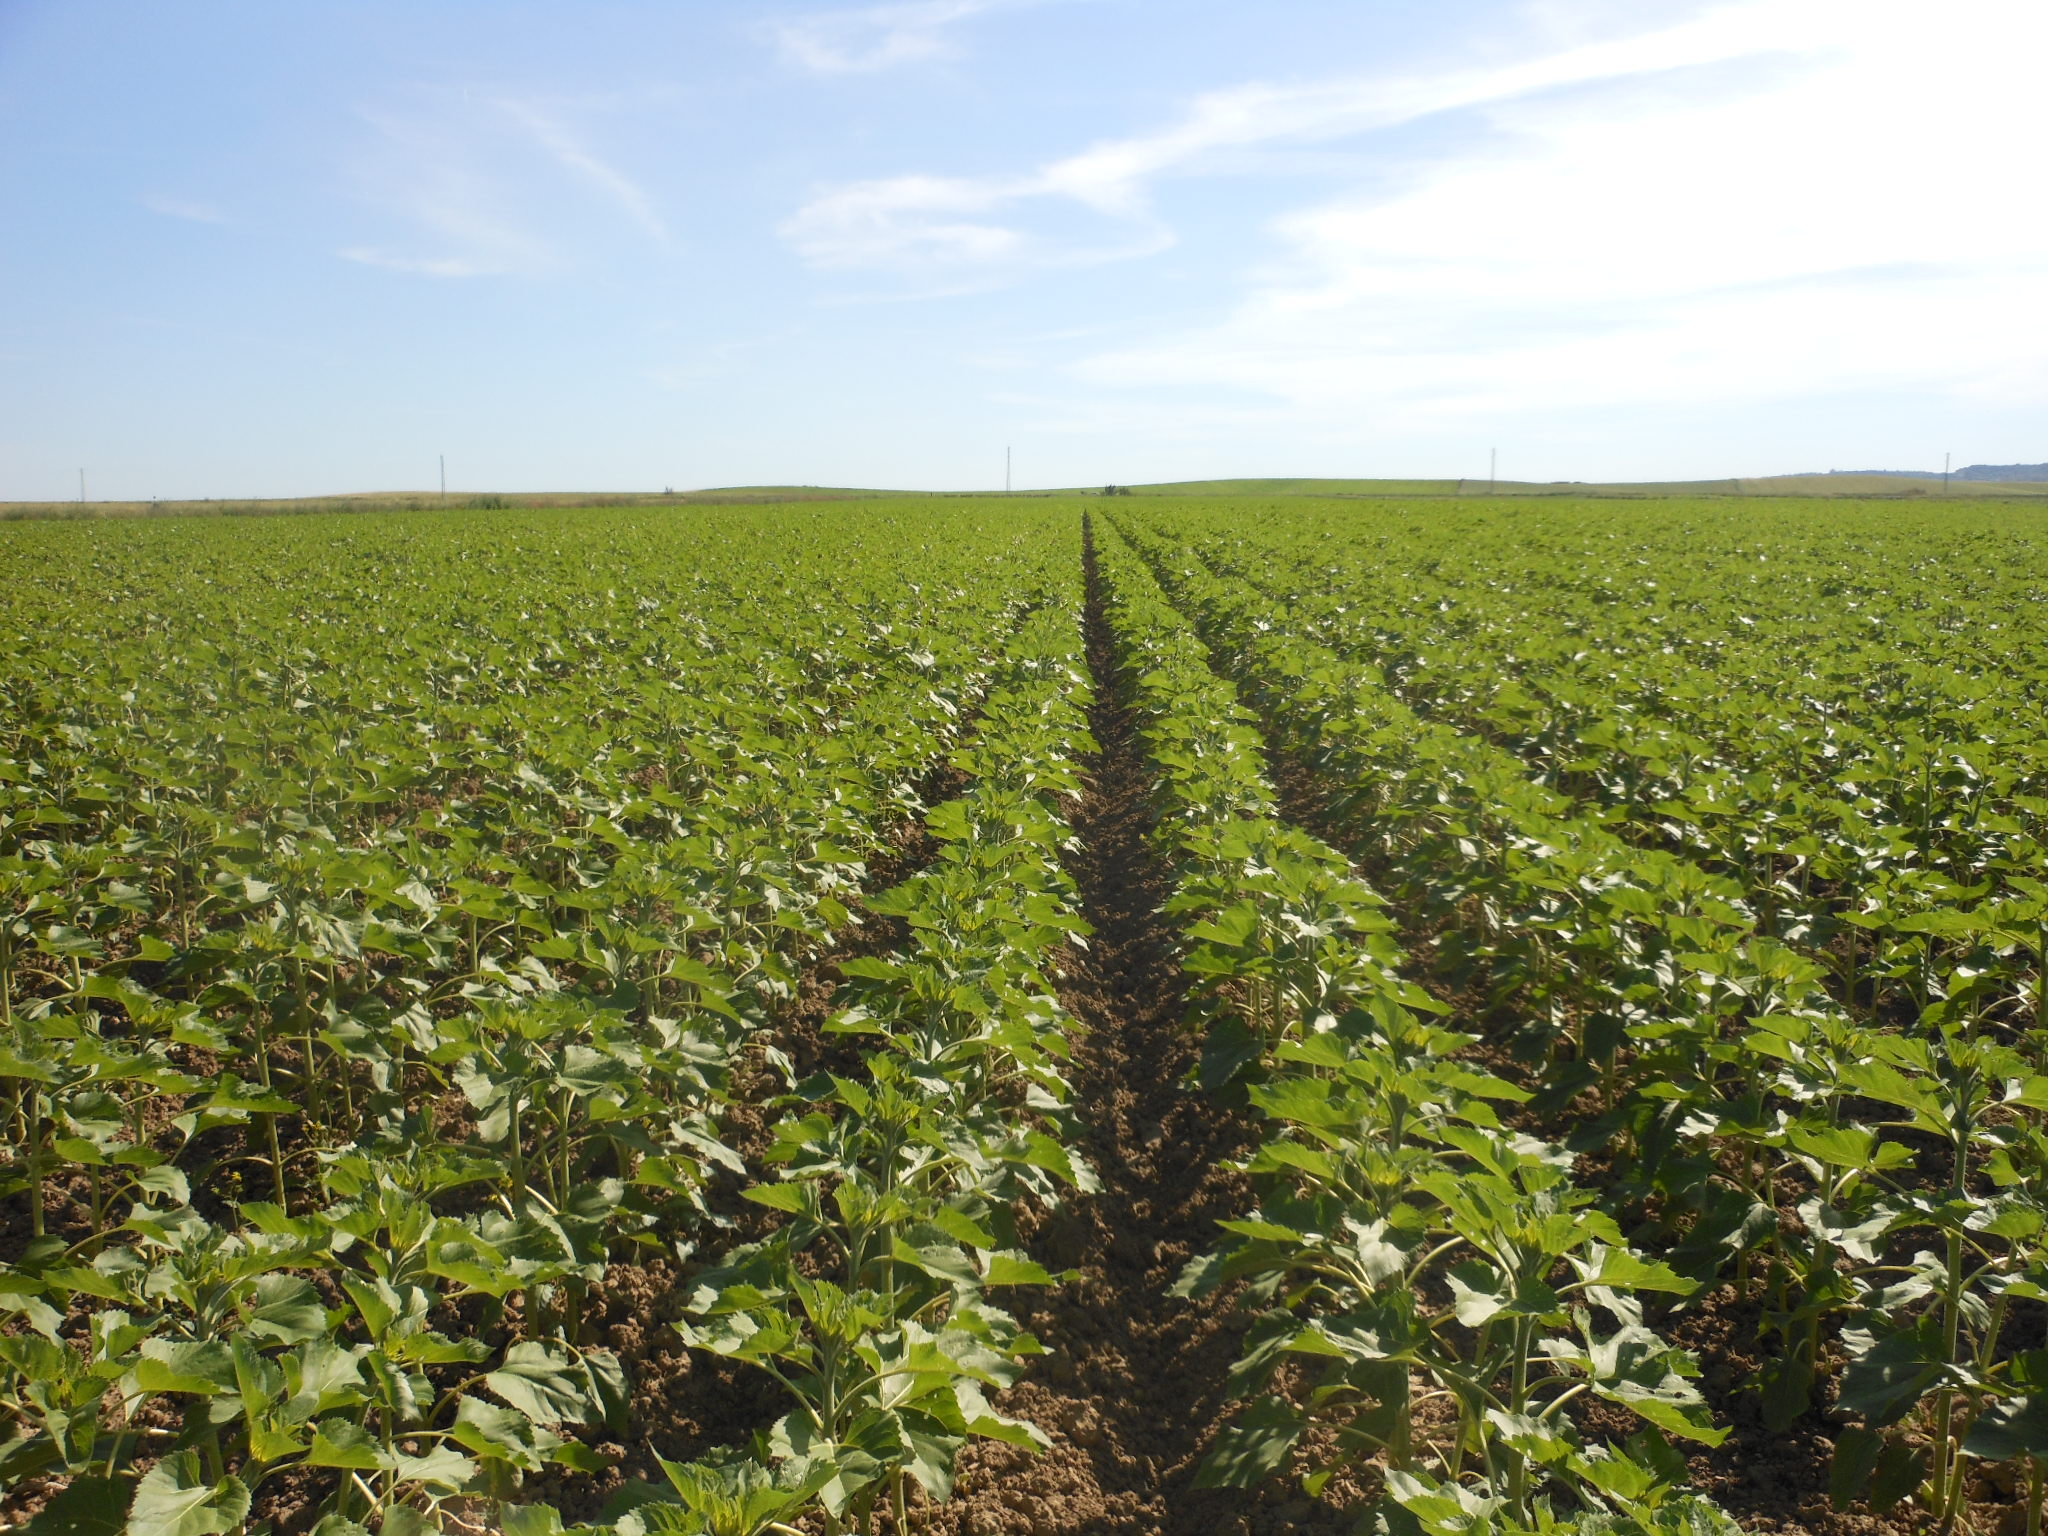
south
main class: Cropland
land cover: Sunflower
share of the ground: 25 - 50 %
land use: Agriculture (excluding fallow land and kitchen gardens)
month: April
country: ES
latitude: 37.4632
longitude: -5.6099
